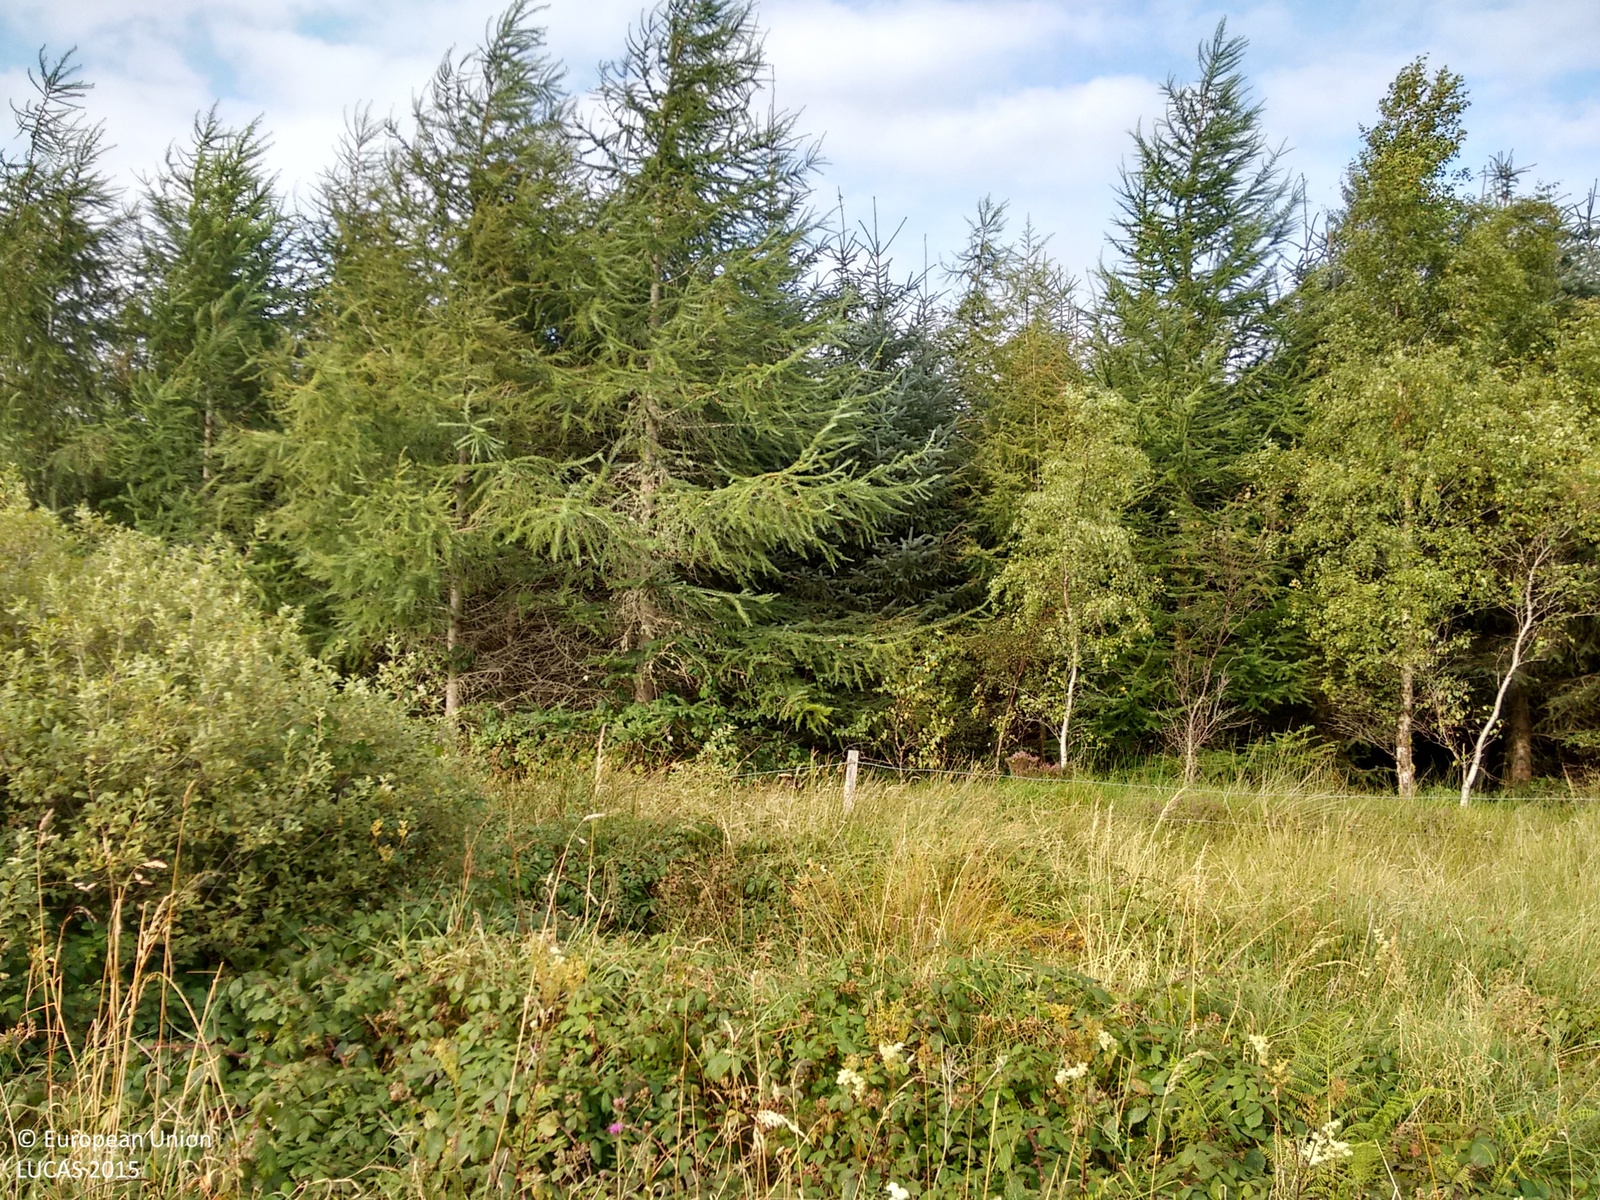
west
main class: Shrubland
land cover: Shrubland without tree cover
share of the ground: > 75 %
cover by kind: shrubs 80 %, herbaceous plants 20 %
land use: Semi-natural and natural areas not in use
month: September
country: IE
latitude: 54.1148
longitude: -9.0128
